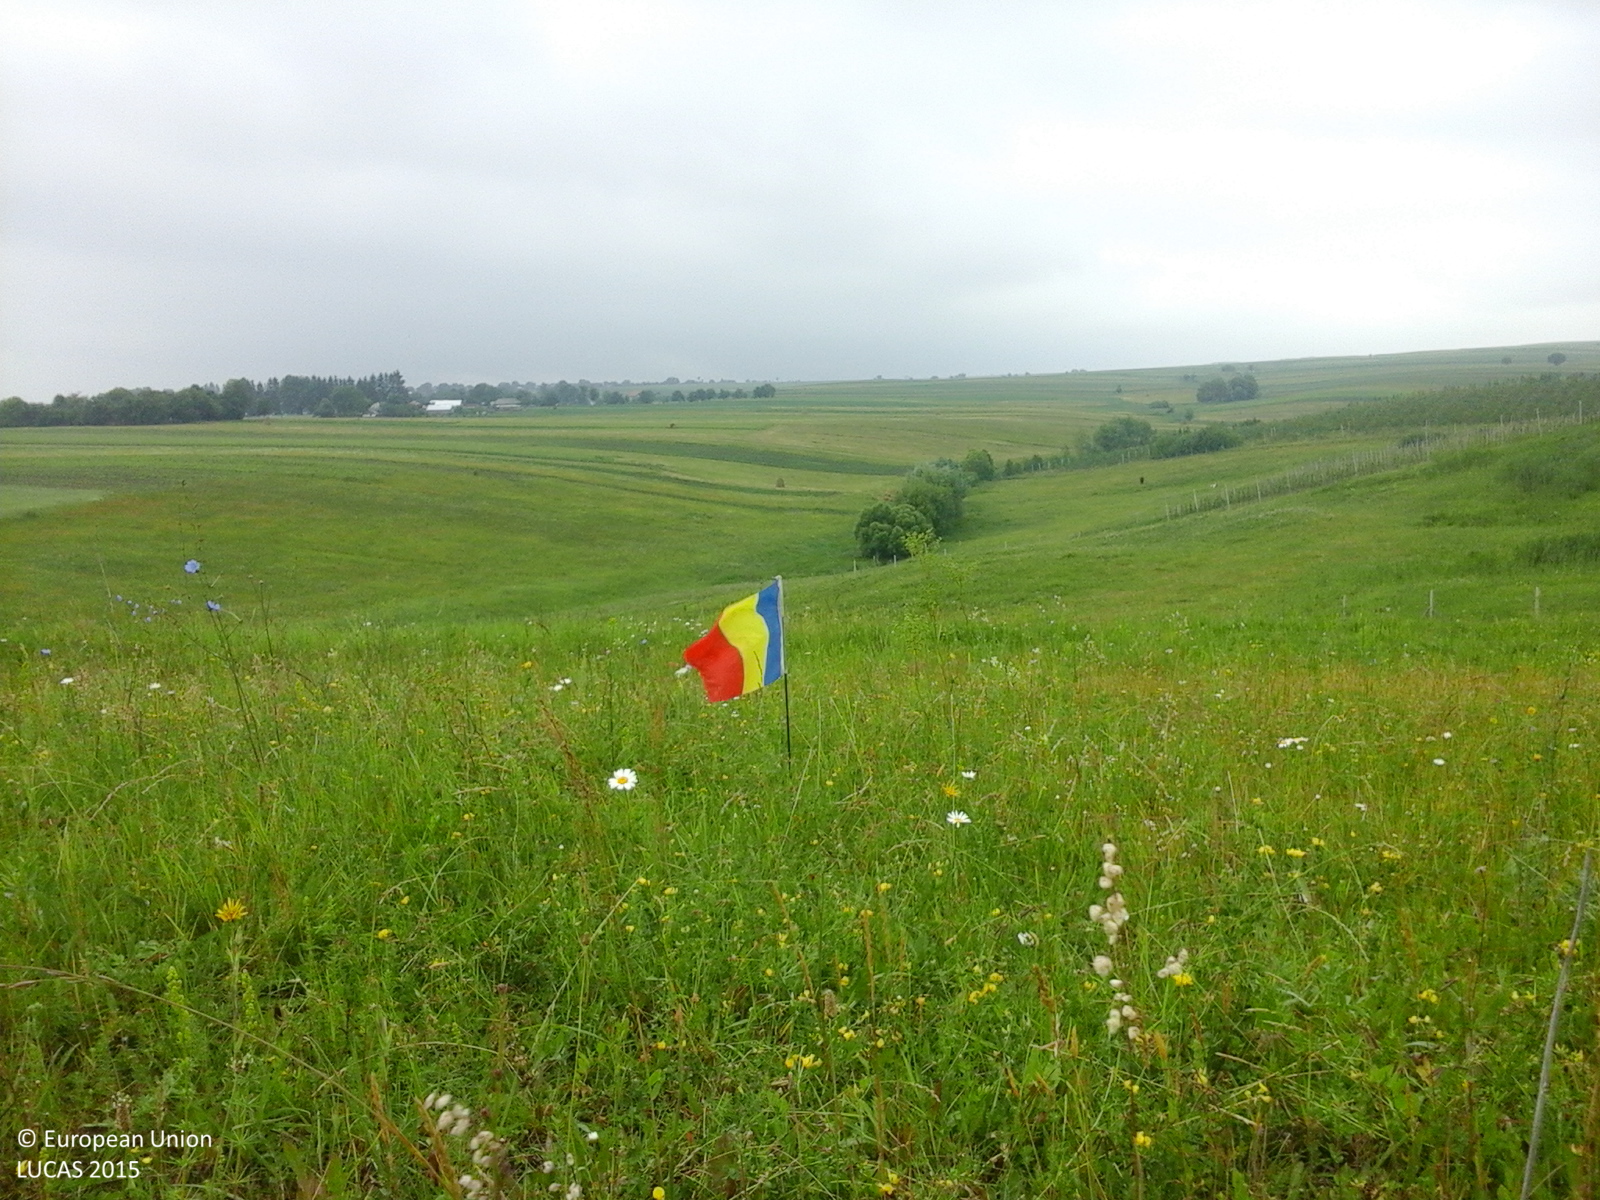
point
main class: Grassland
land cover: Grassland without tree/shrub cover
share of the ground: > 75 %
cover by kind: herbaceous plants 100 %
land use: Agriculture (excluding fallow land and kitchen gardens)
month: June
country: RO
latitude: 47.3931
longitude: 26.3669
